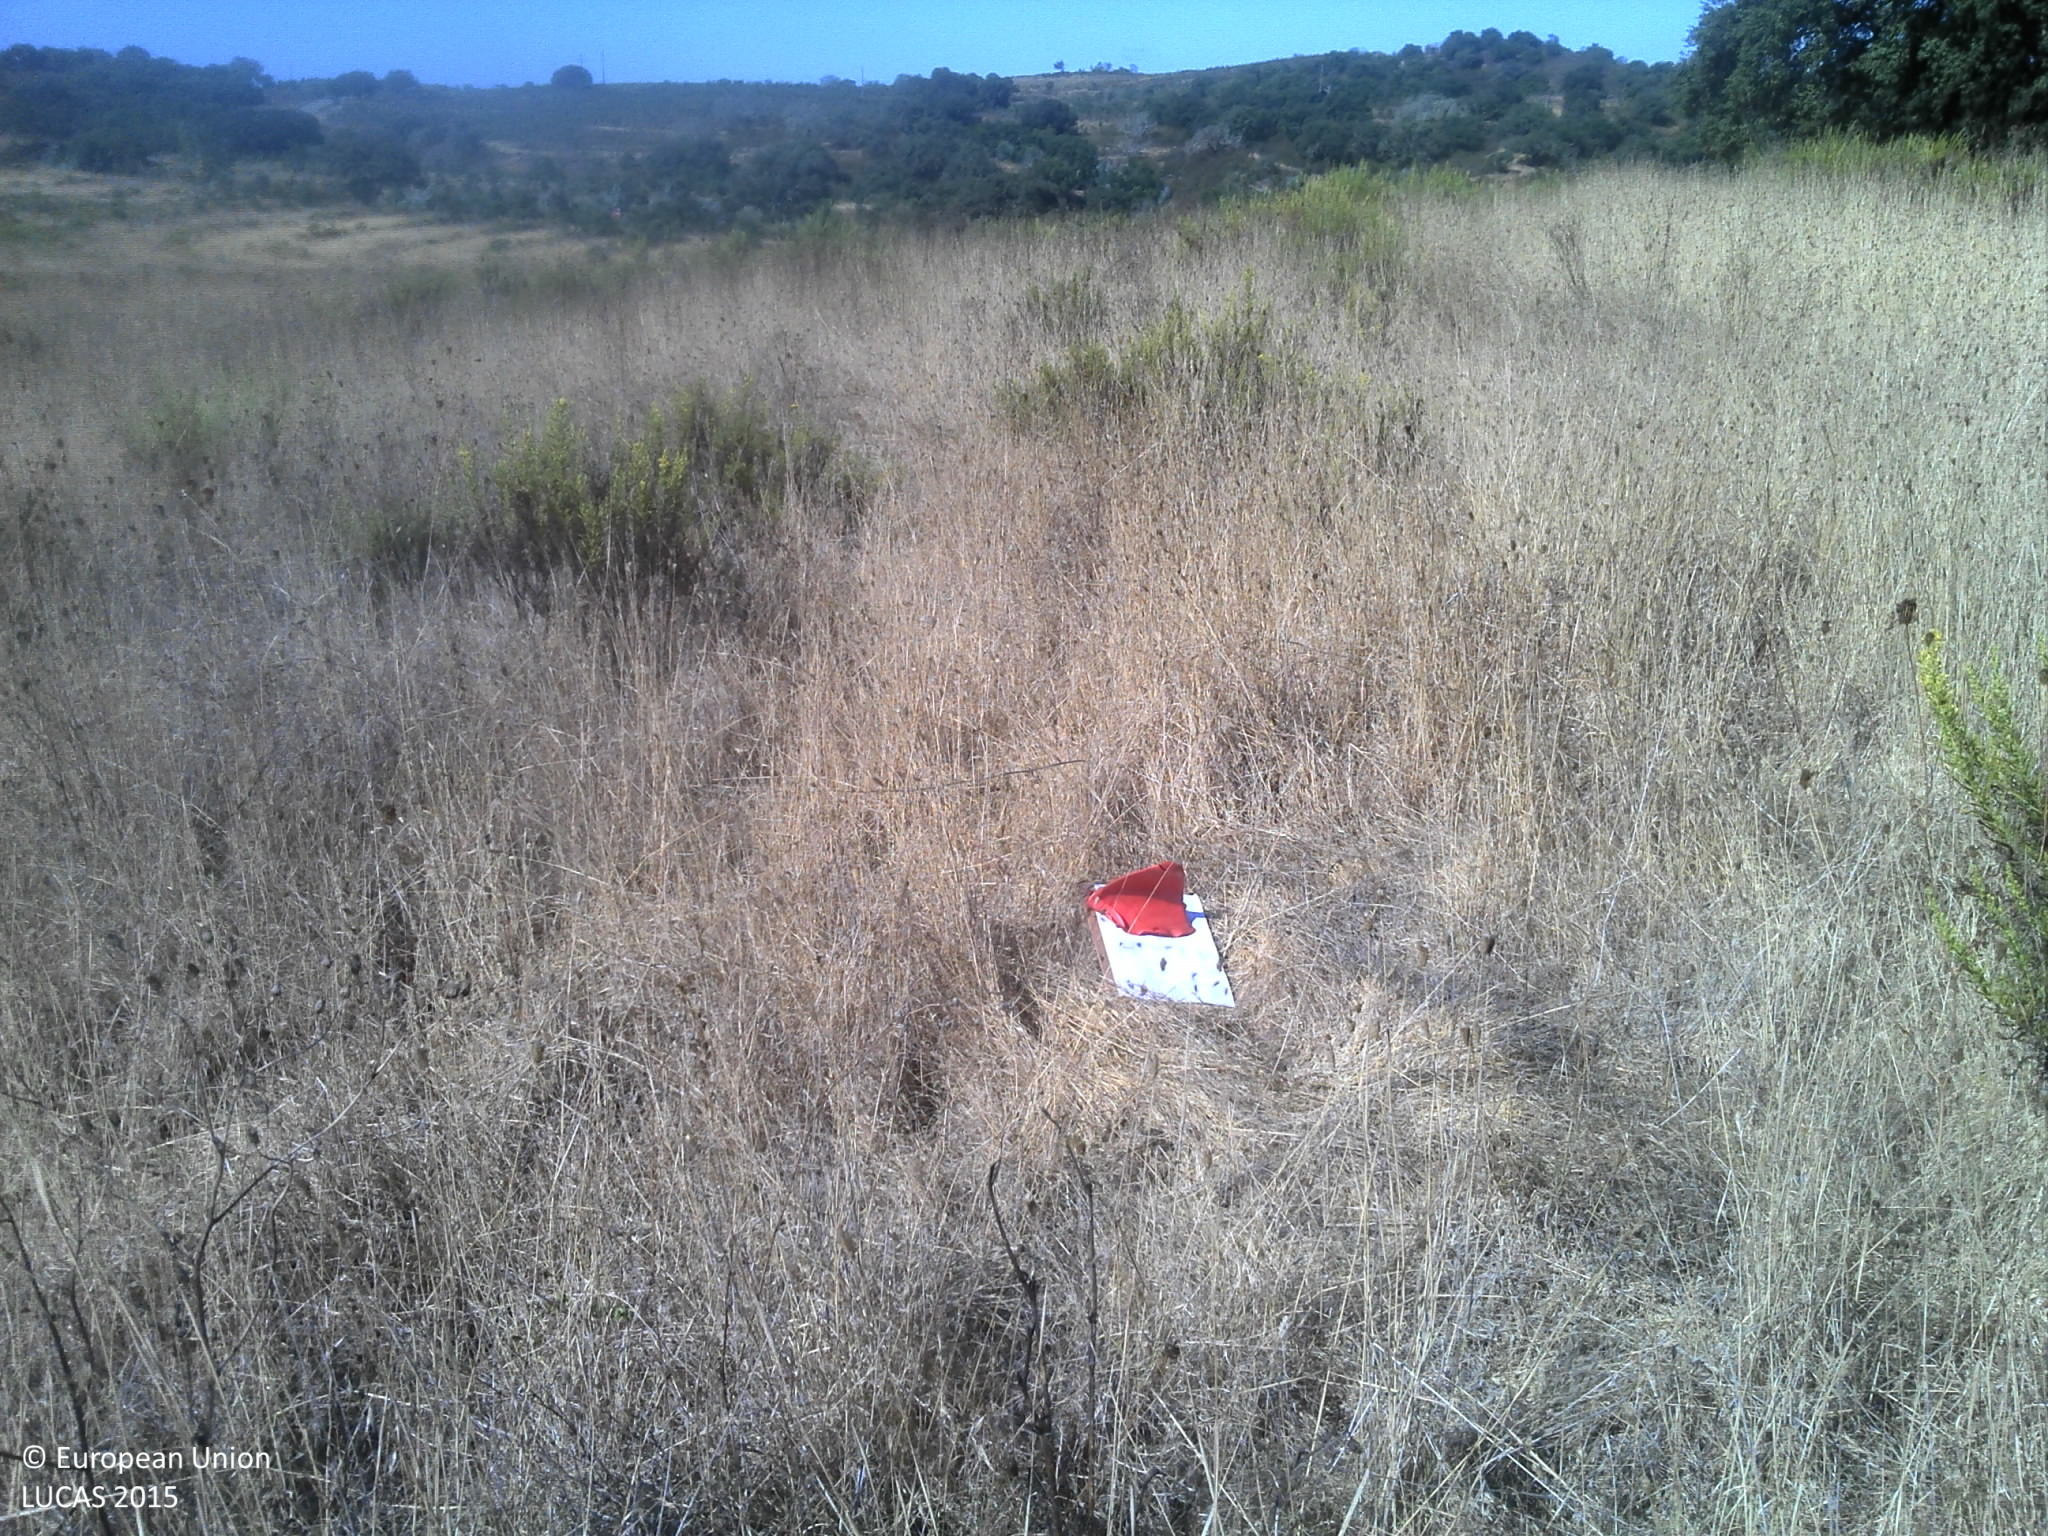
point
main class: Grassland
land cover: Grassland without tree/shrub cover
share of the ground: > 75 %
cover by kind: herbaceous plants 75 %, unconsolidated bare surface 25 %
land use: Agriculture (excluding fallow land and kitchen gardens)
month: August
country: PT
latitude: 37.5561
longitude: -8.4500
